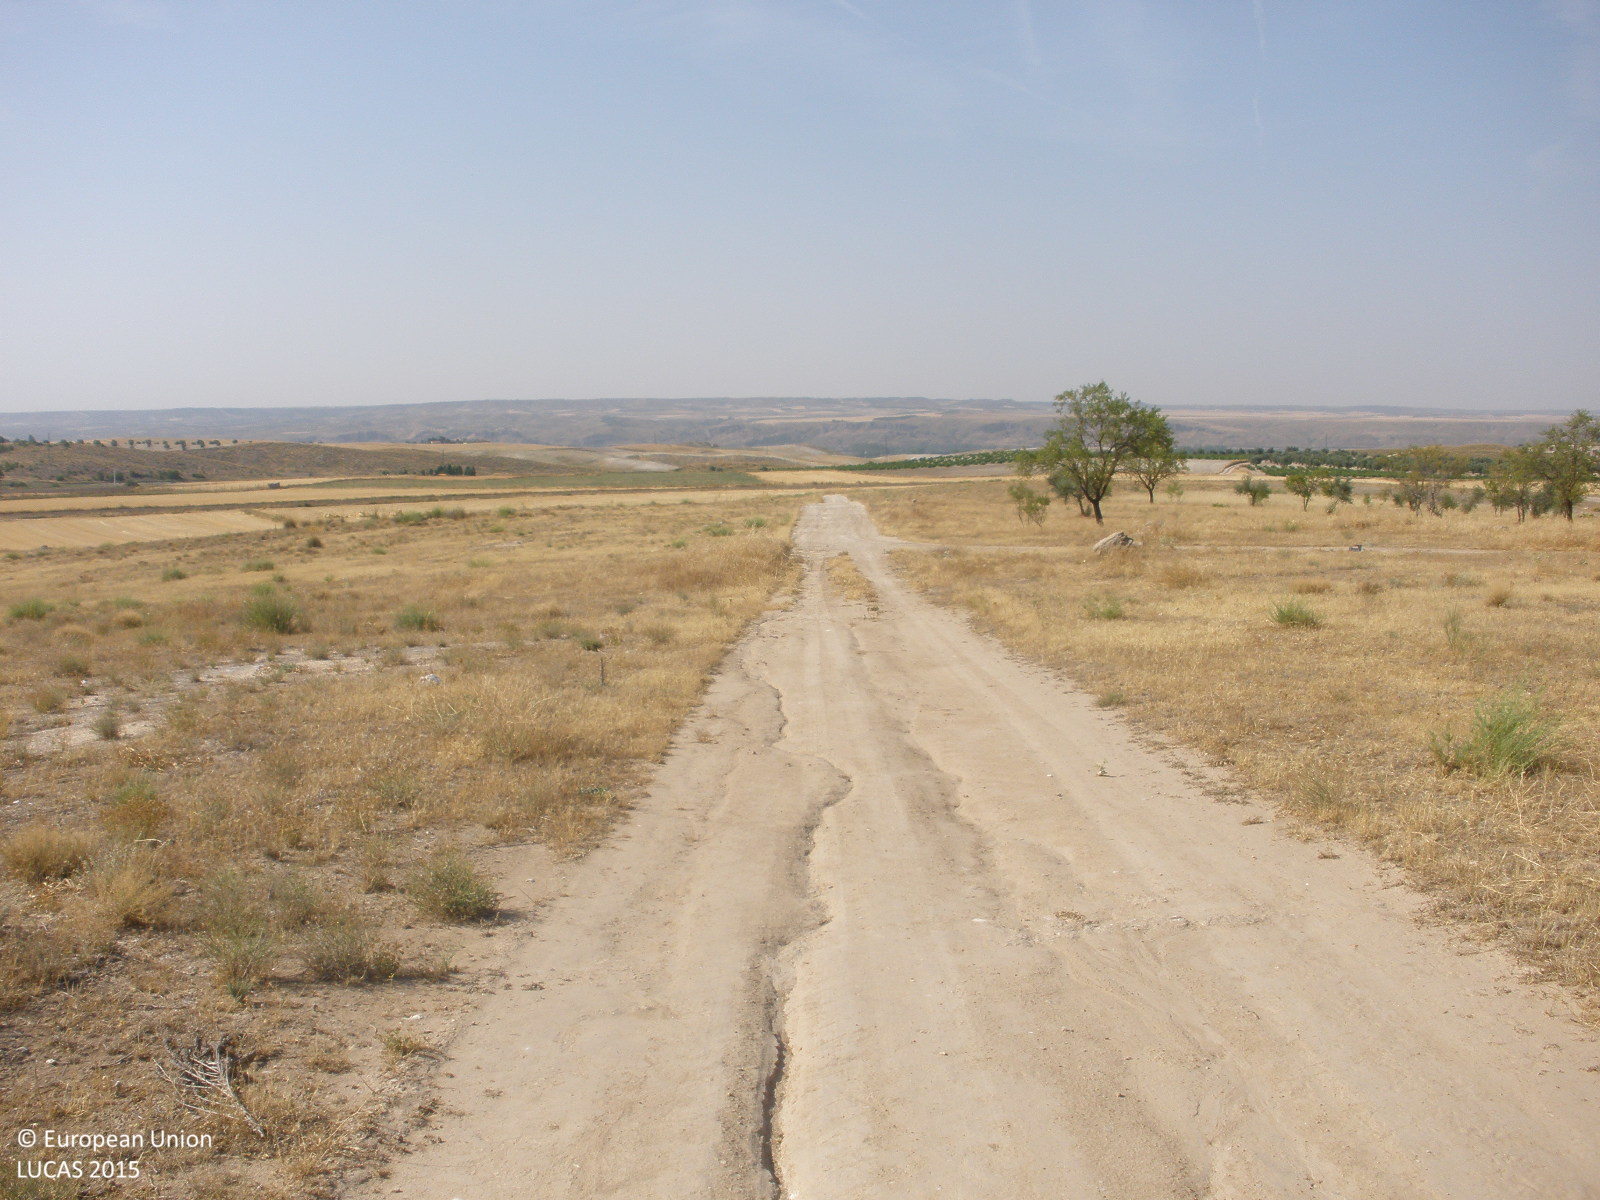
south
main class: Shrubland
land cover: Shrubland without tree cover
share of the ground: 25 - 50 %
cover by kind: herbaceous plants 50 %, shrubs 30 %, consolidated bare surface 20 %
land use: Semi-natural and natural areas not in use
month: July
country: ES
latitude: 40.0976
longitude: -3.5086
